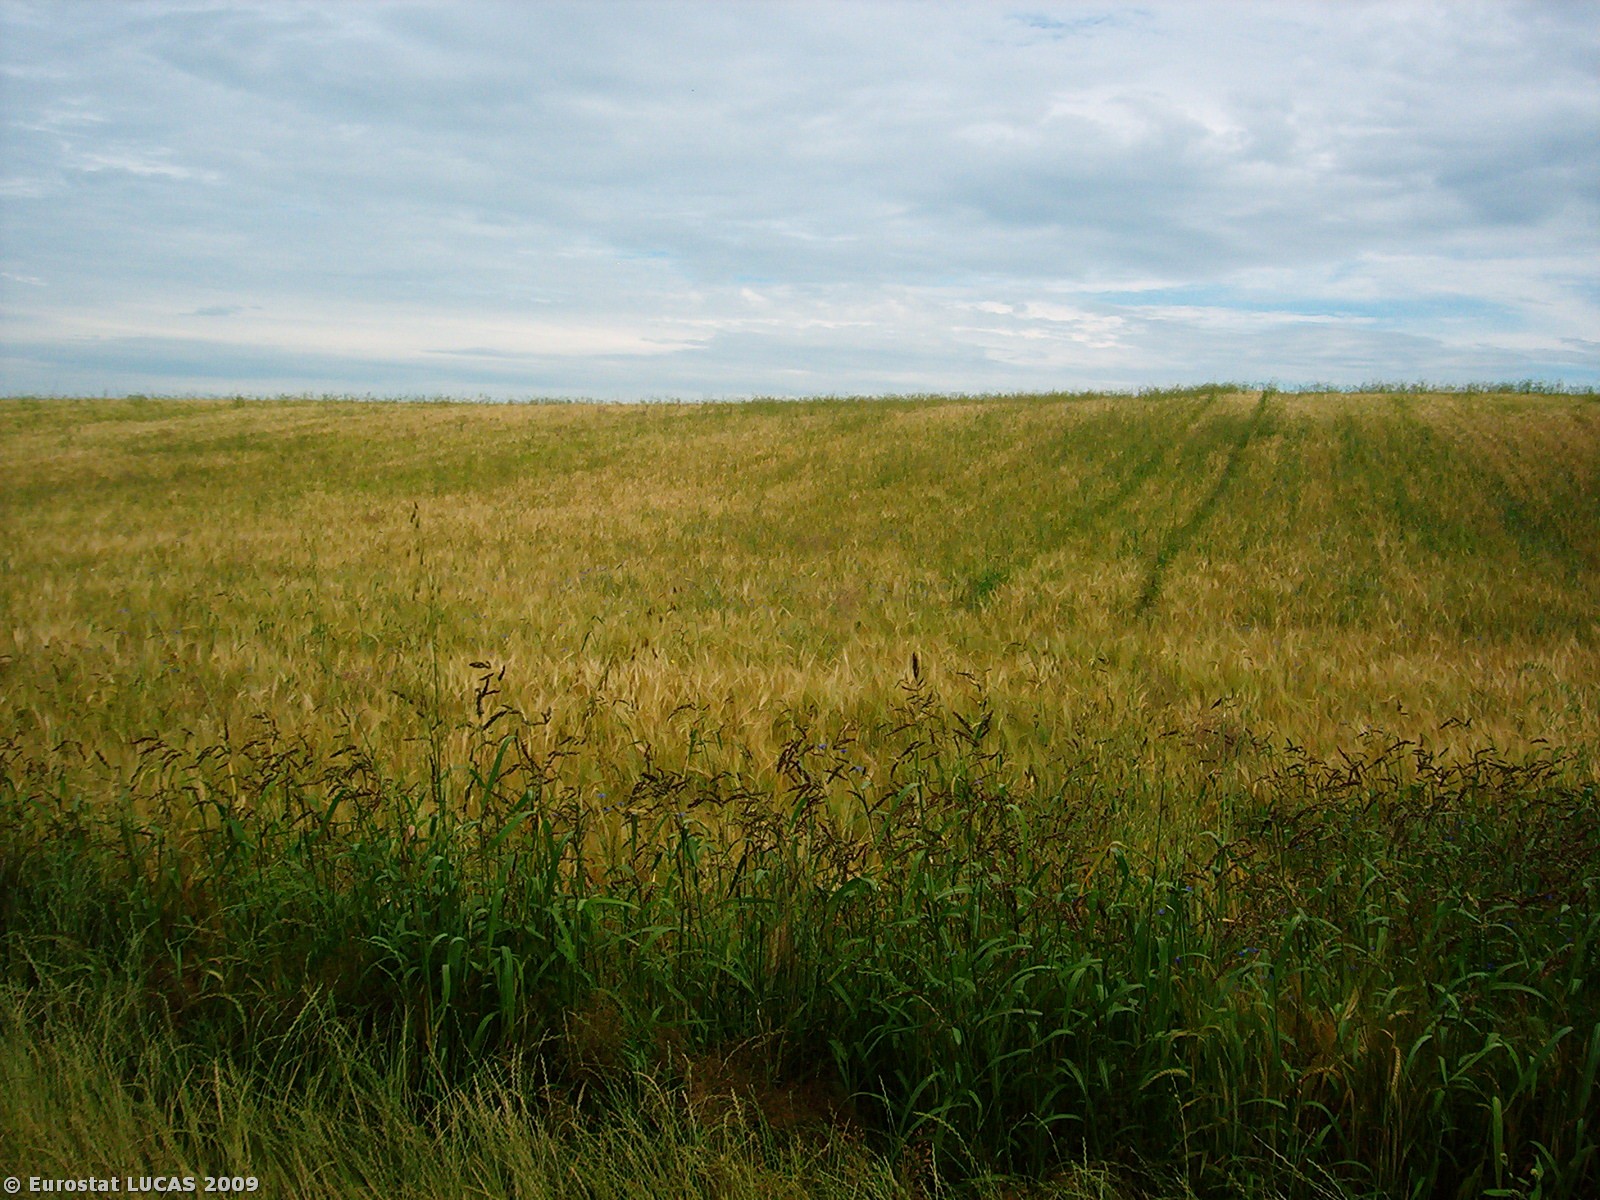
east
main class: Cropland
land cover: Maize
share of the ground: > 75 %
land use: Agriculture (excluding fallow land and kitchen gardens)
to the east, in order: Maize; Fences; Grass margins; Tracks; Grass margins; Barley
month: July
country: PL
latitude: 52.3989
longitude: 15.3975
